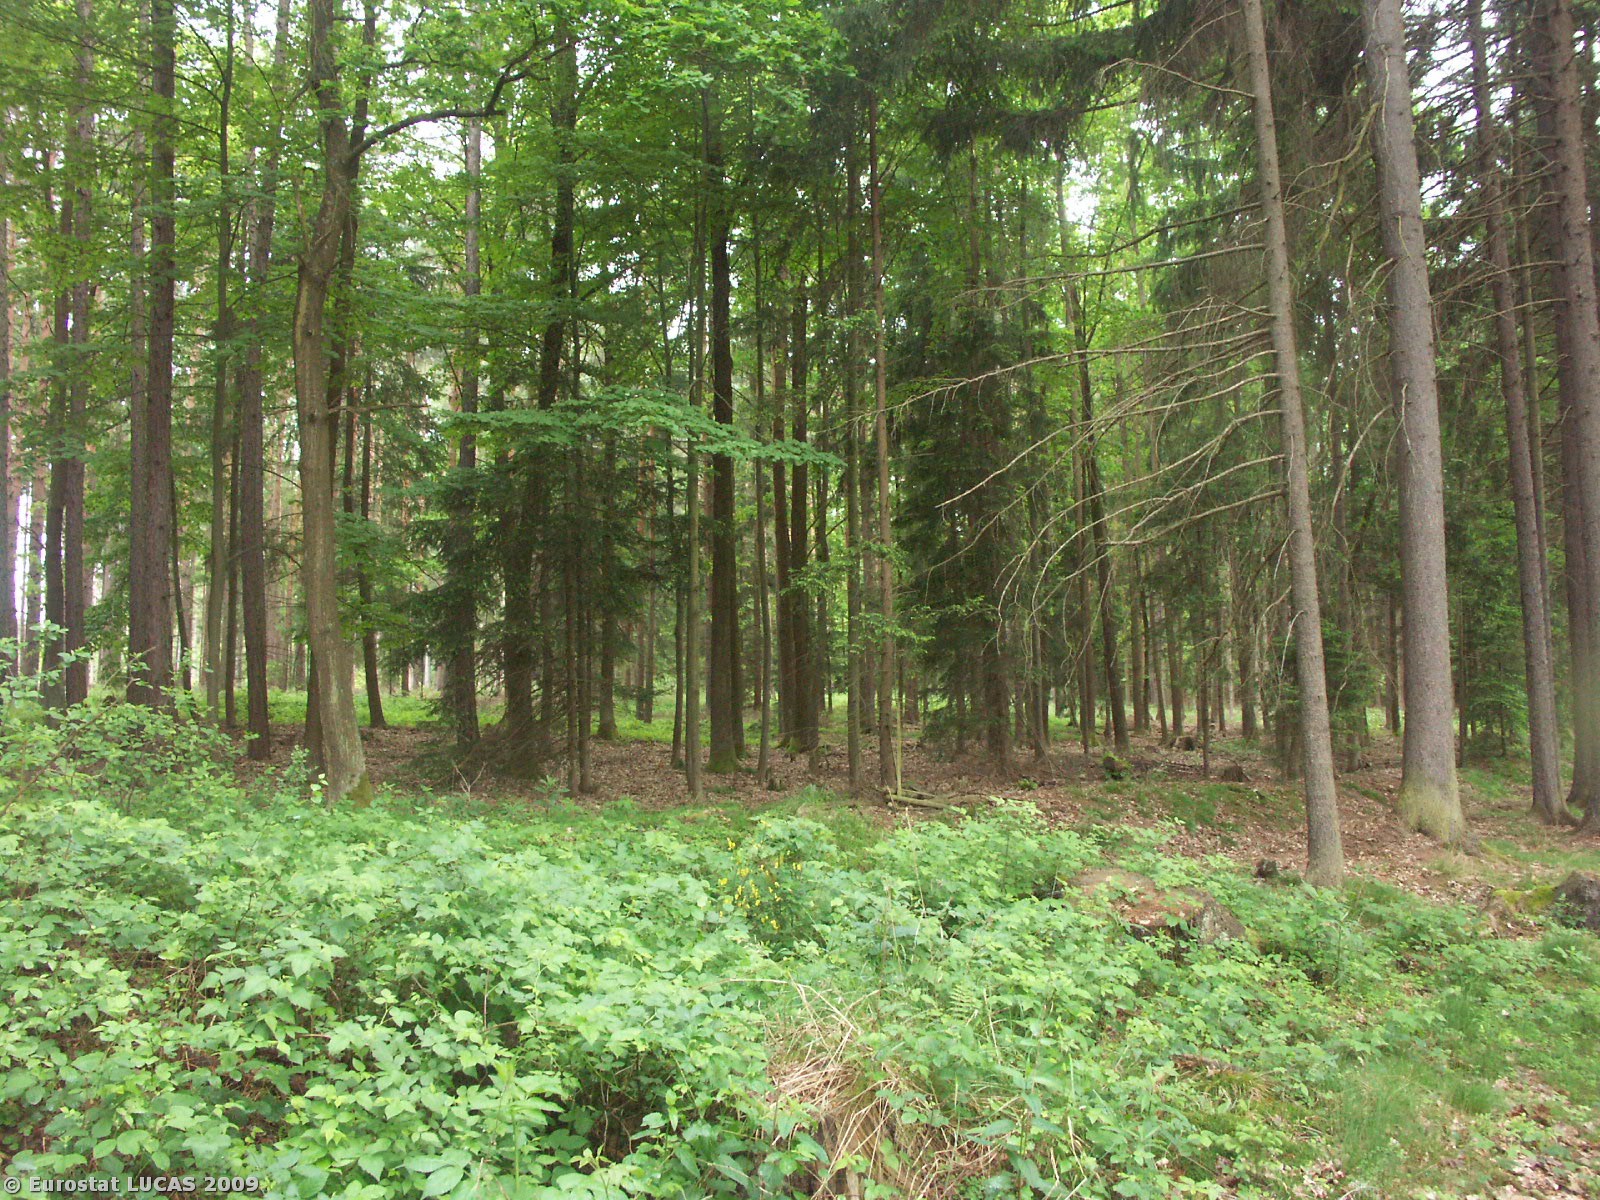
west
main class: Woodland
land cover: Mixed woodland
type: hemiboreal forest and nemoral coniferous forest and mixed broadleaved-coniferous forest
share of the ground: > 75 %
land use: Forestry
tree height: > 5 m
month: May
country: CZ
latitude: 48.8644
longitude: 14.6497
